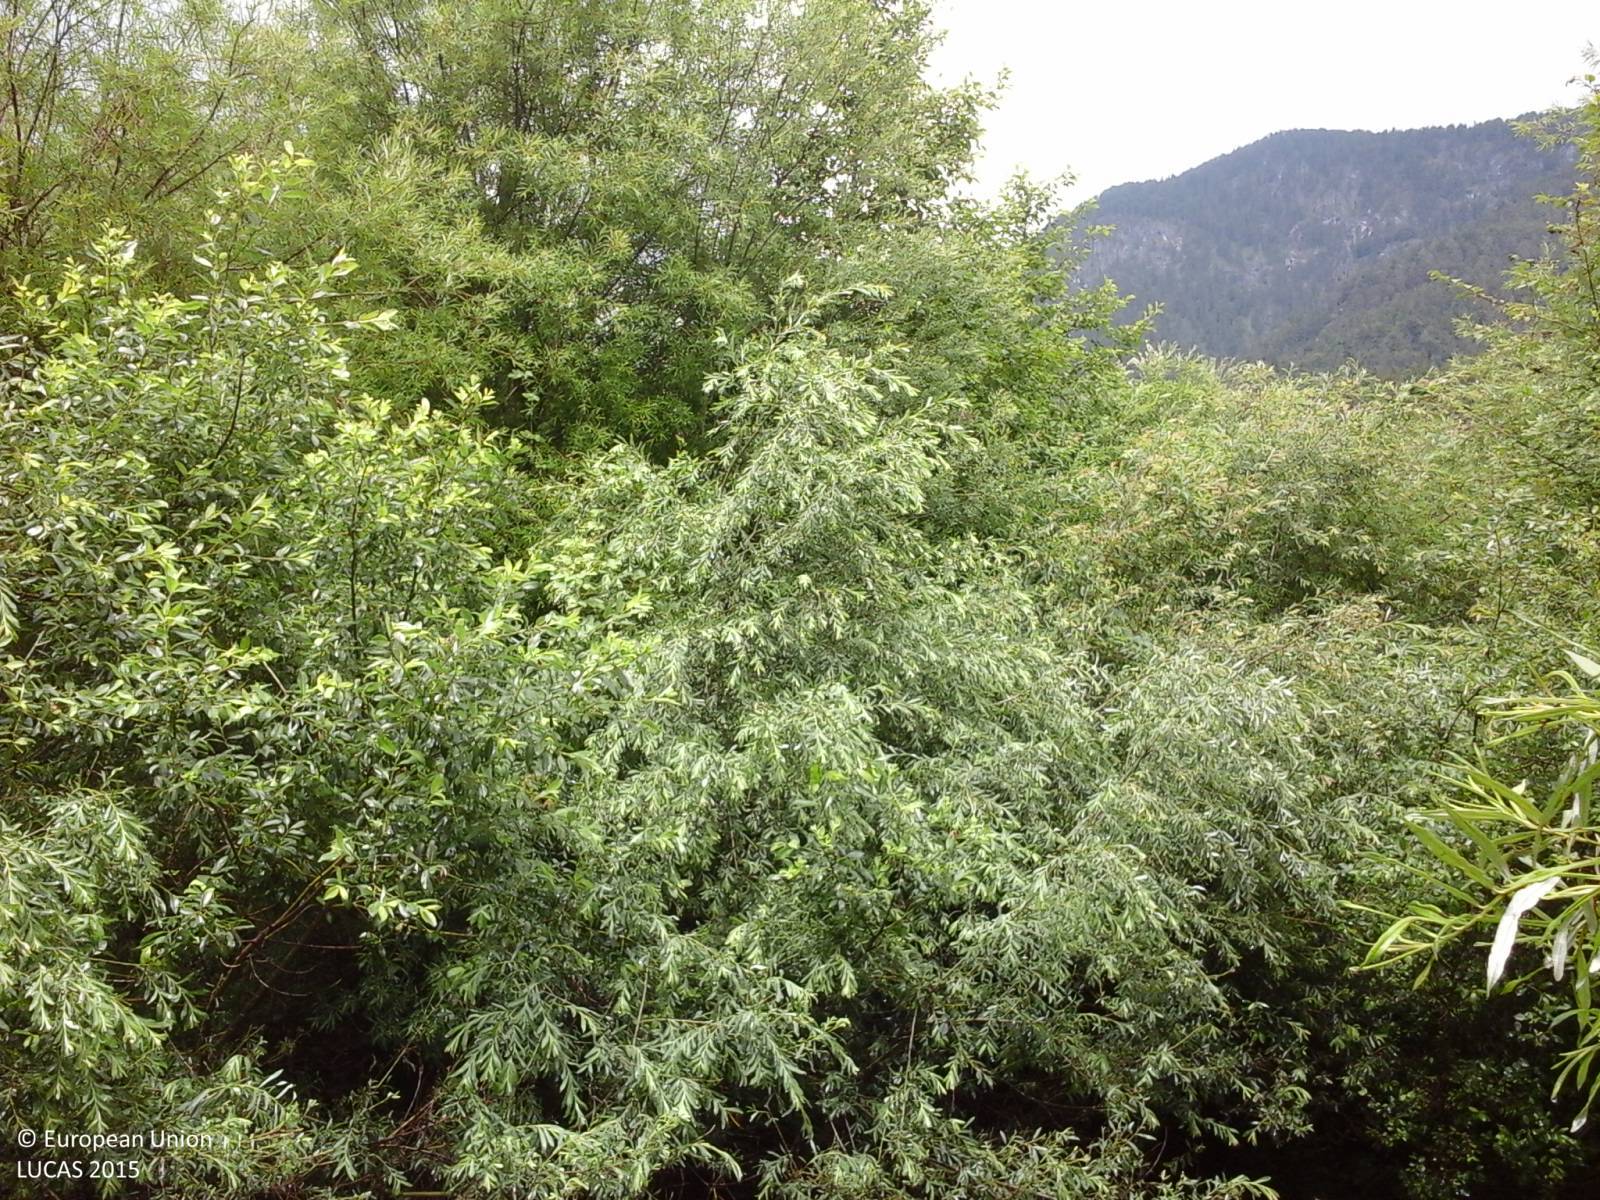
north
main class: Woodland
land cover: Broadleaved woodland
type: thermophilous deciduous forest
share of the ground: > 75 %
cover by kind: broadleaved forest trees 80 %, shrubs 10 %, herbaceous plants 10 %
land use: Semi-natural and natural areas not in use
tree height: > 5 m
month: June
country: IT
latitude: 46.5085
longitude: 13.5548
